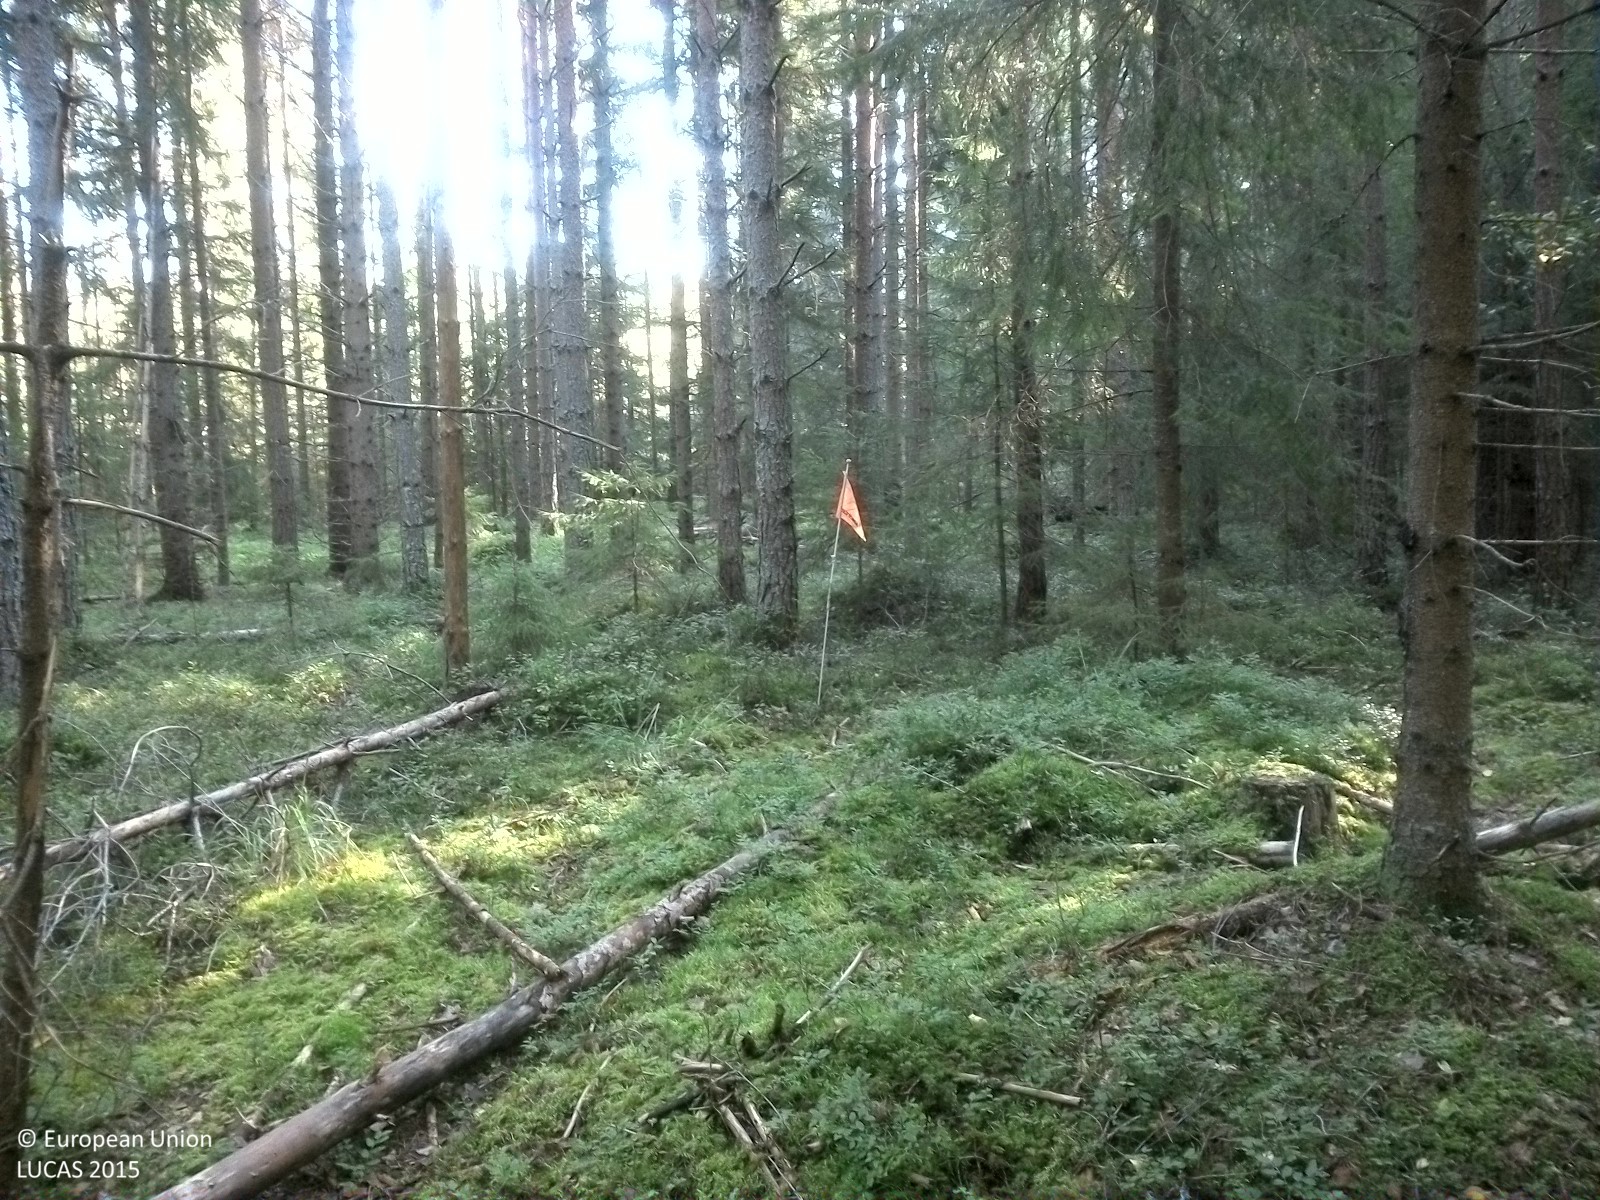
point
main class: Woodland
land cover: Other coniferous woodland
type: boreal forest
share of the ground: 25 - 50 %
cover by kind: coniferous forest trees 45 %, herbaceous plants 35 %, lichens and mosses 20 %
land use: Forestry
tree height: > 5 m
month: September
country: SE
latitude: 59.1030
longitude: 15.8417
